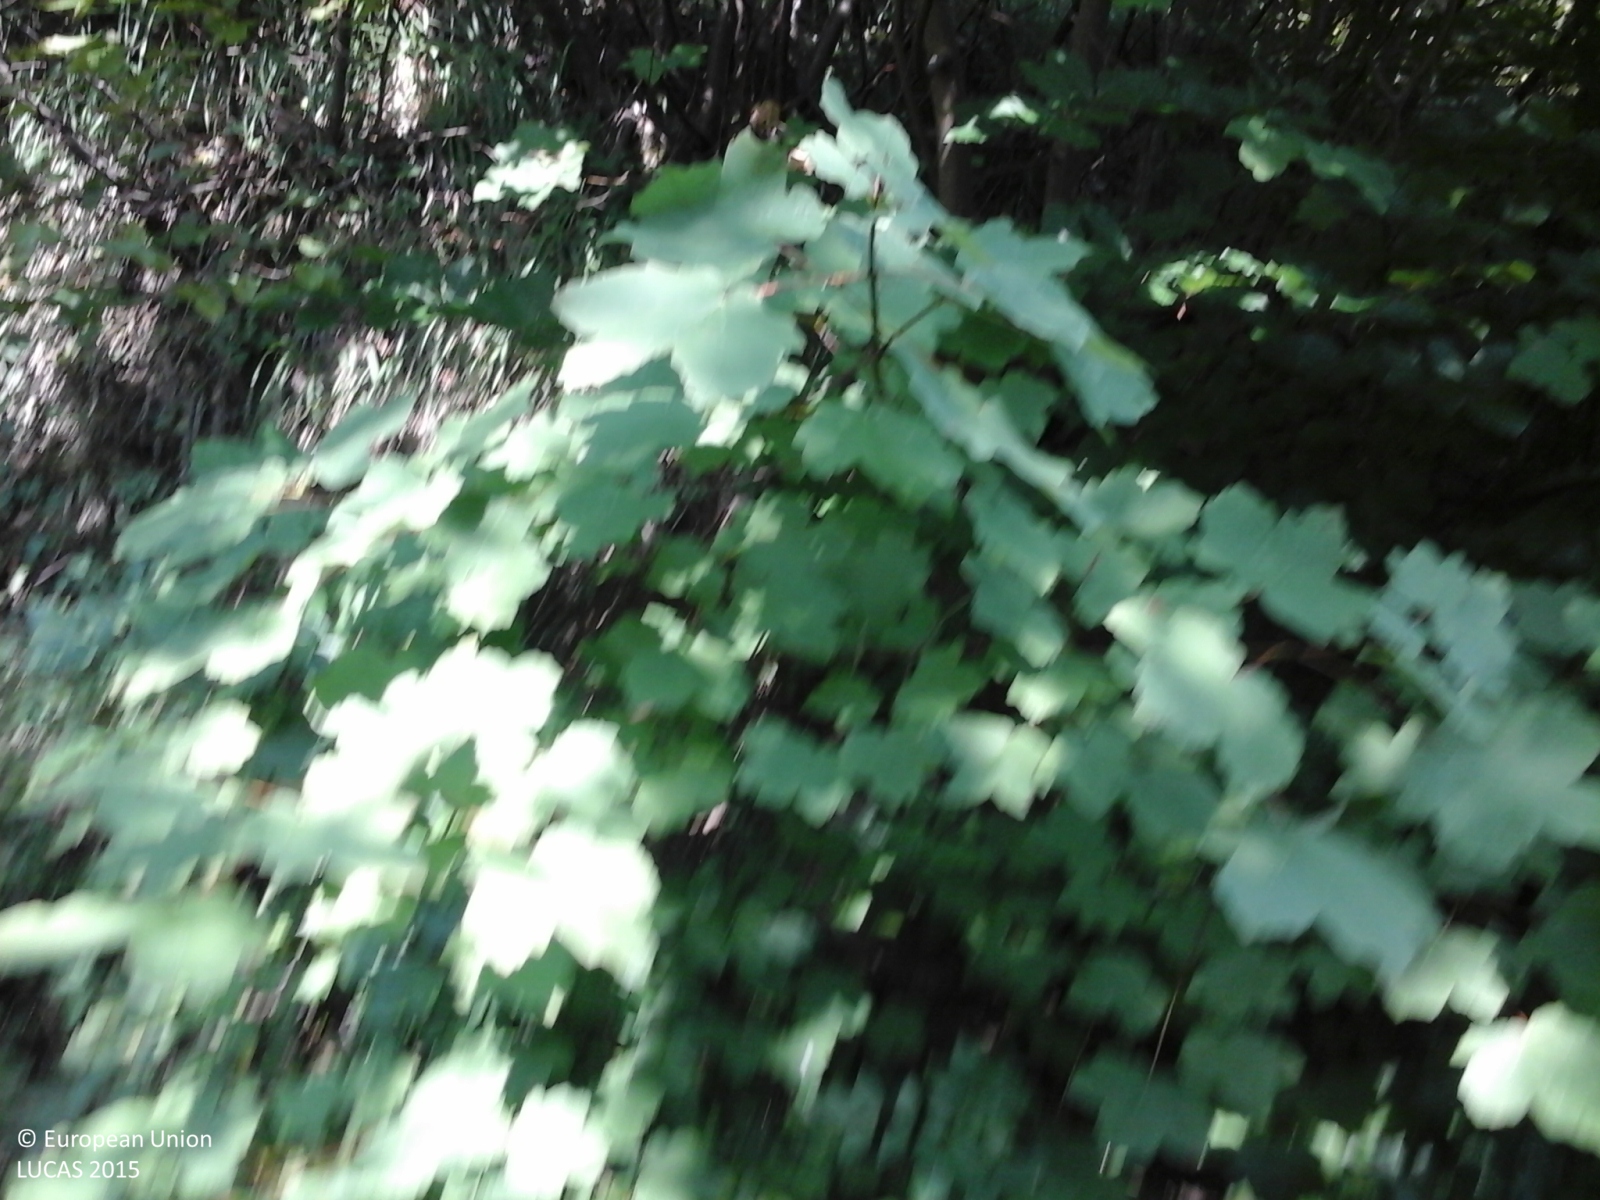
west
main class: Woodland
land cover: Broadleaved woodland
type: thermophilous deciduous forest
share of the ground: > 75 %
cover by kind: broadleaved forest trees 100 %
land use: Forestry
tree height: > 5 m
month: August
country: IT
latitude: 43.7494
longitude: 12.2174
